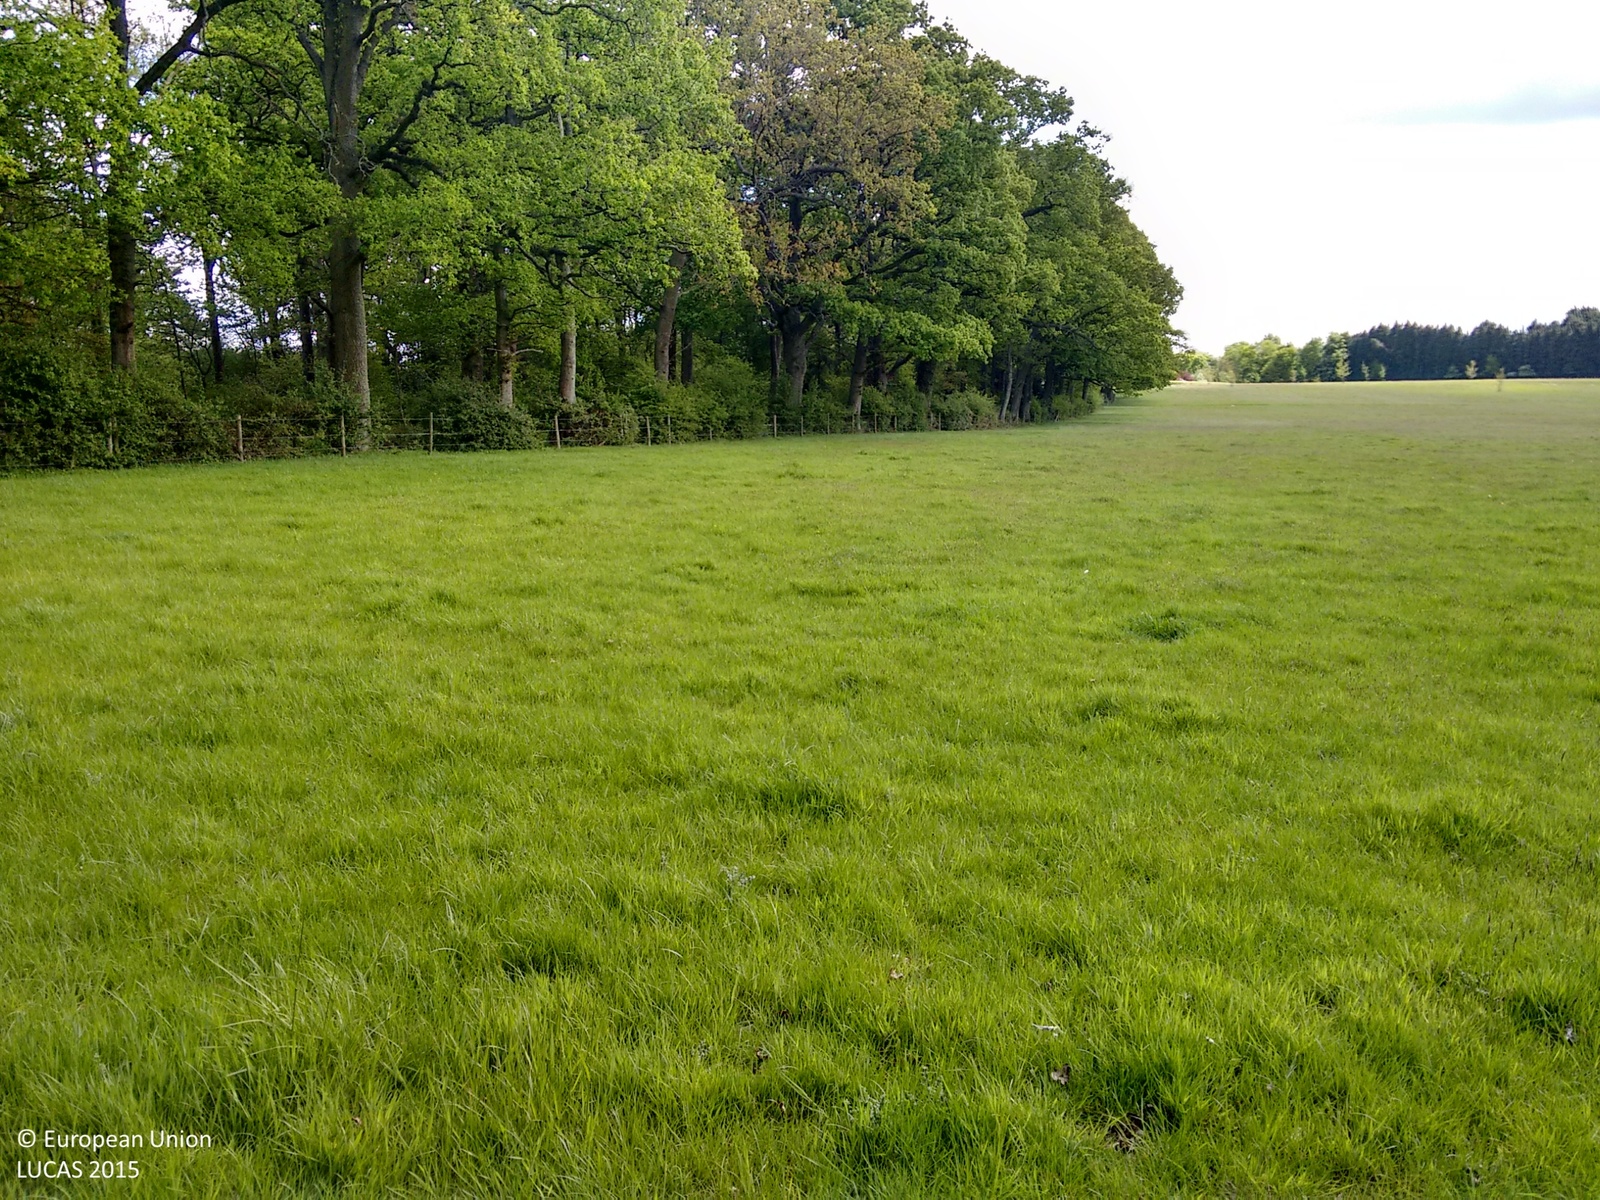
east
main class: Grassland
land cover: Grassland without tree/shrub cover
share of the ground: > 75 %
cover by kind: herbaceous plants 100 %
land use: Agriculture (excluding fallow land and kitchen gardens)
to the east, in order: Grassland without tree/shrub cover; Broadleaved woodland; Fences; Broadleaved woodland; Ditches and canals; Broadleaved woodland; Paved roads, cycling and walking lanes; Broadleaved woodland; Grass margins; Common wheat
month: May
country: GB
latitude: 51.3249
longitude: -1.1392
